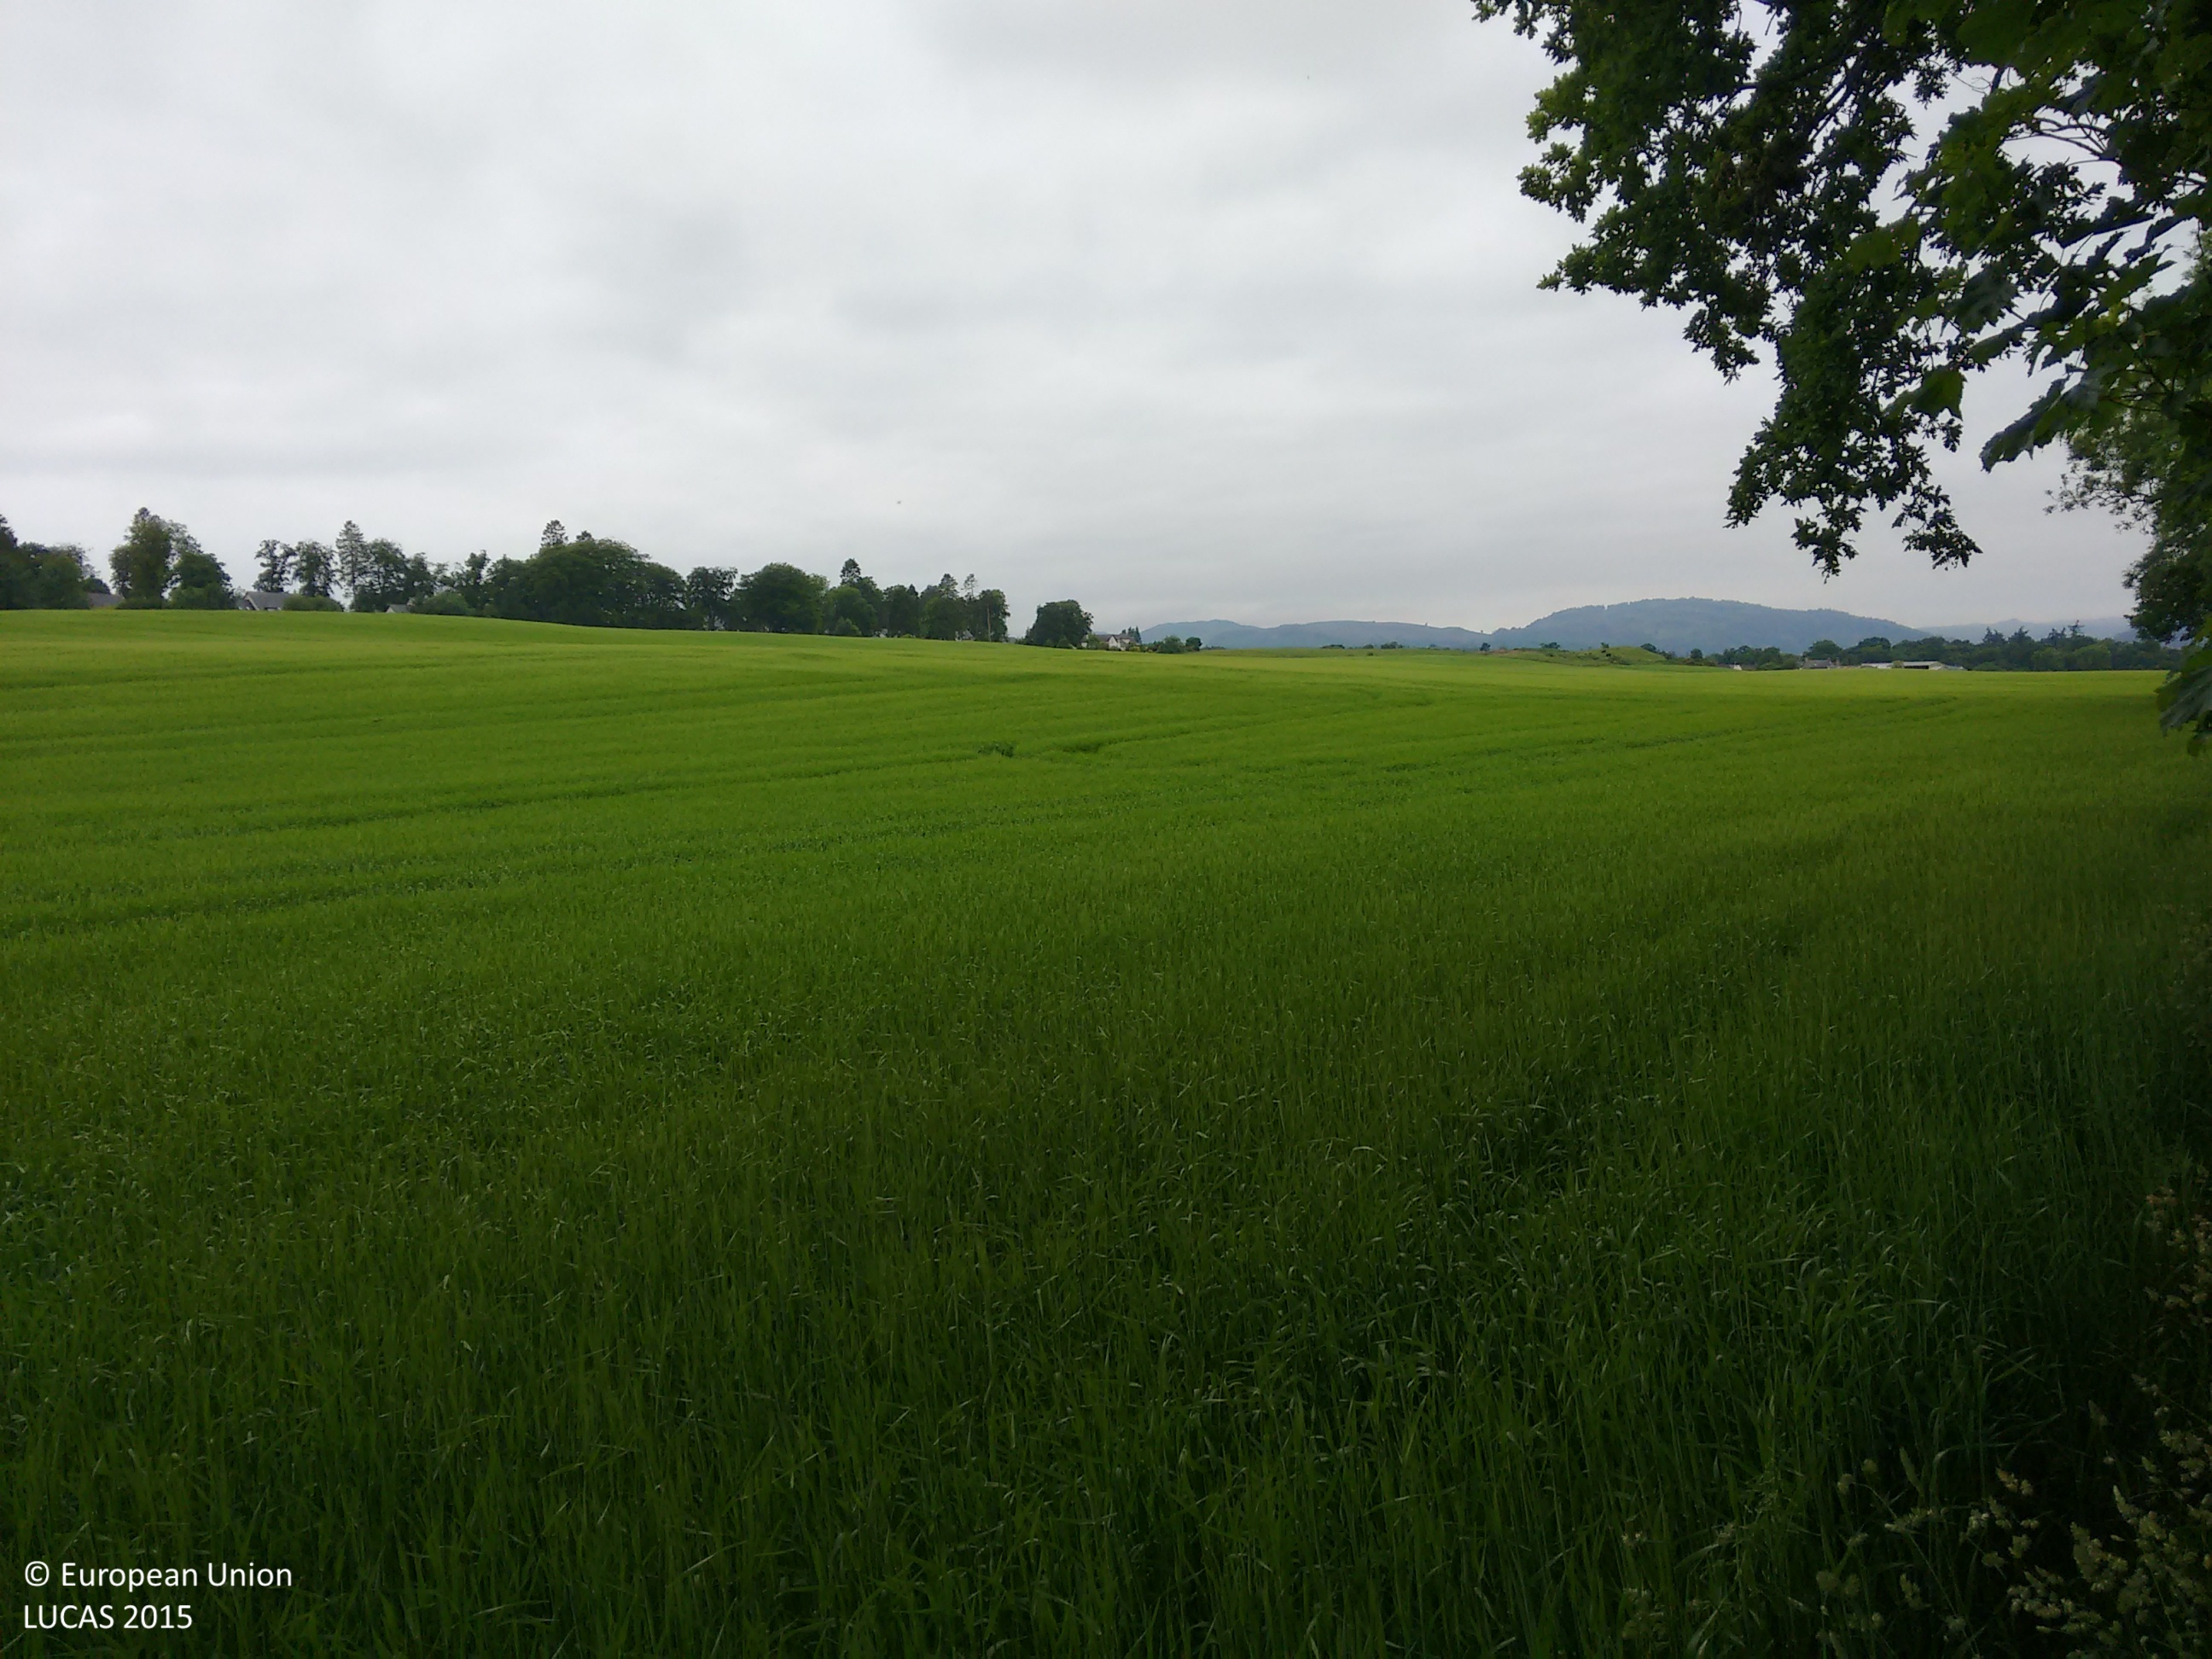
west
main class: Woodland
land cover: Broadleaved woodland
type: mesophytic deciduous forest
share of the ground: > 75 %
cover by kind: broadleaved forest trees 100 %
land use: Agriculture (excluding fallow land and kitchen gardens)
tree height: > 5 m
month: June
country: GB
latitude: 56.5338
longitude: -3.4559
